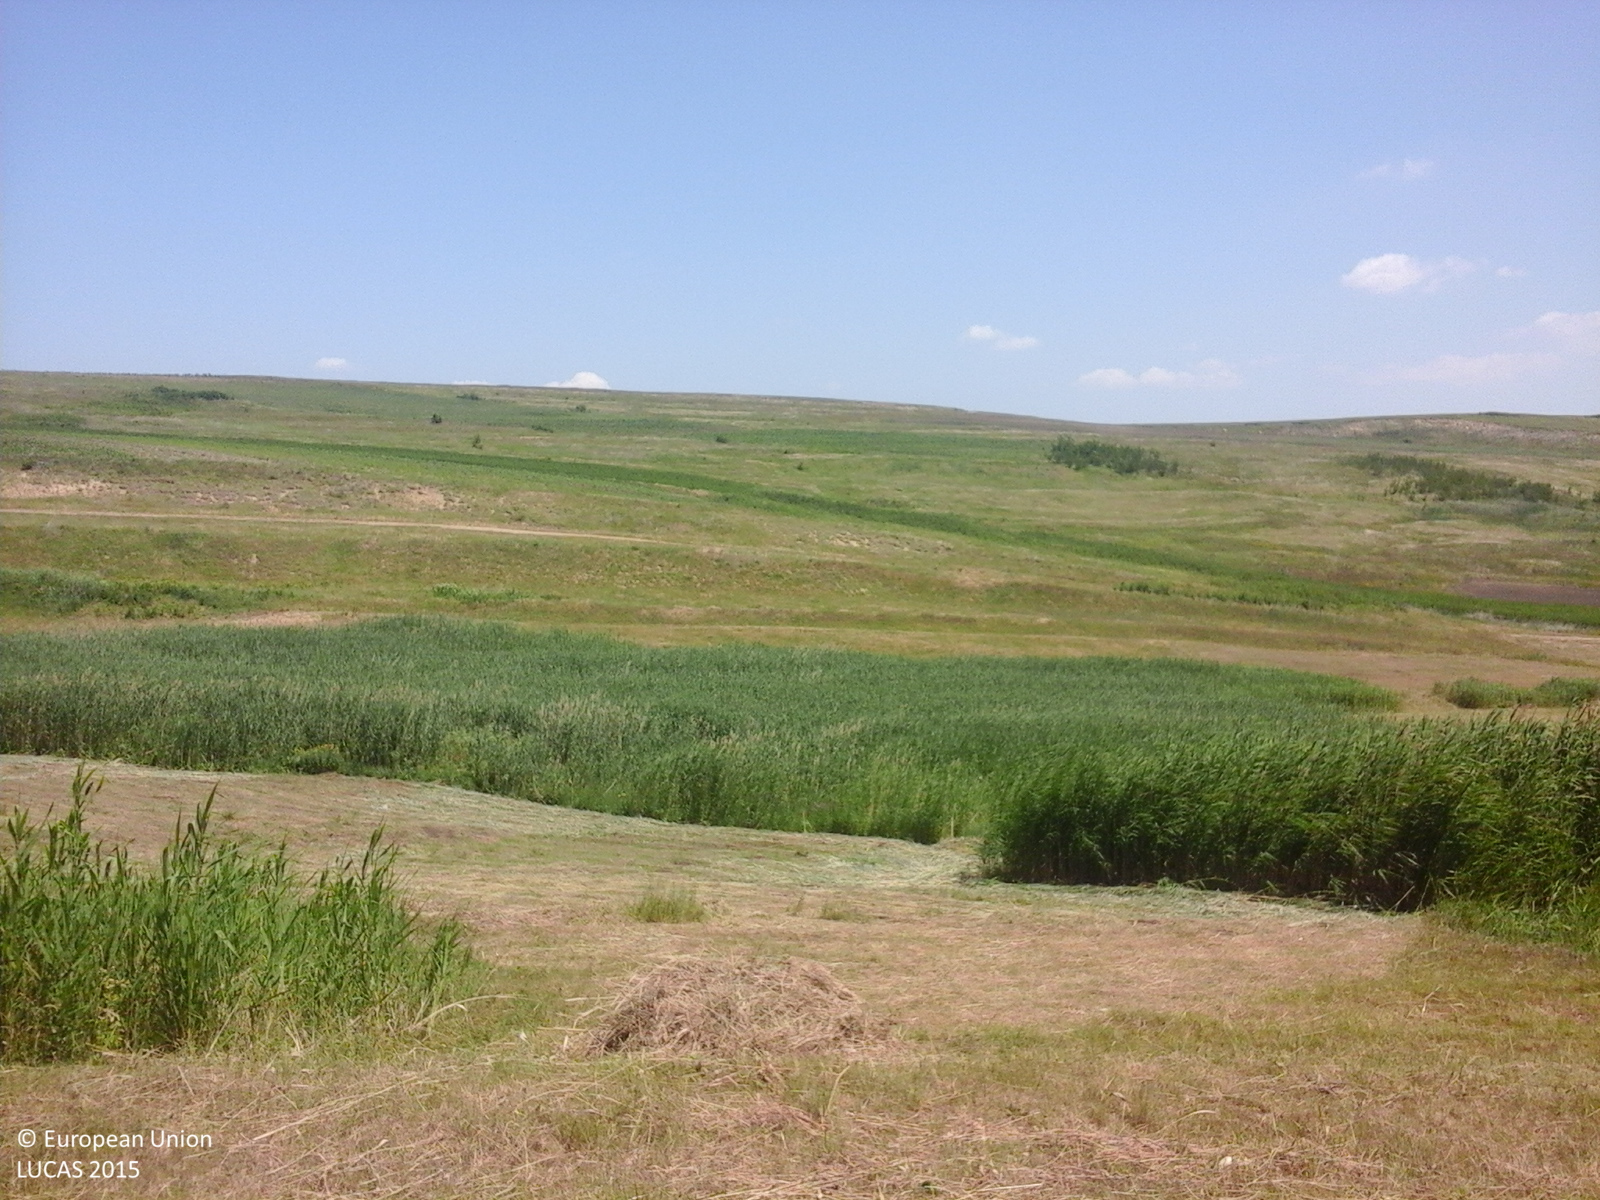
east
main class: Grassland
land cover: Grassland without tree/shrub cover
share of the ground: > 75 %
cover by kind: herbaceous plants 100 %
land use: Agriculture (excluding fallow land and kitchen gardens)
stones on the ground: < 10 %
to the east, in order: Grassland without tree/shrub cover; Inland marshes; Grassland without tree/shrub cover; Tracks; Grassland without tree/shrub cover; Abandoned hedges; Sunflower
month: June
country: RO
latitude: 47.4544
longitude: 27.1512
